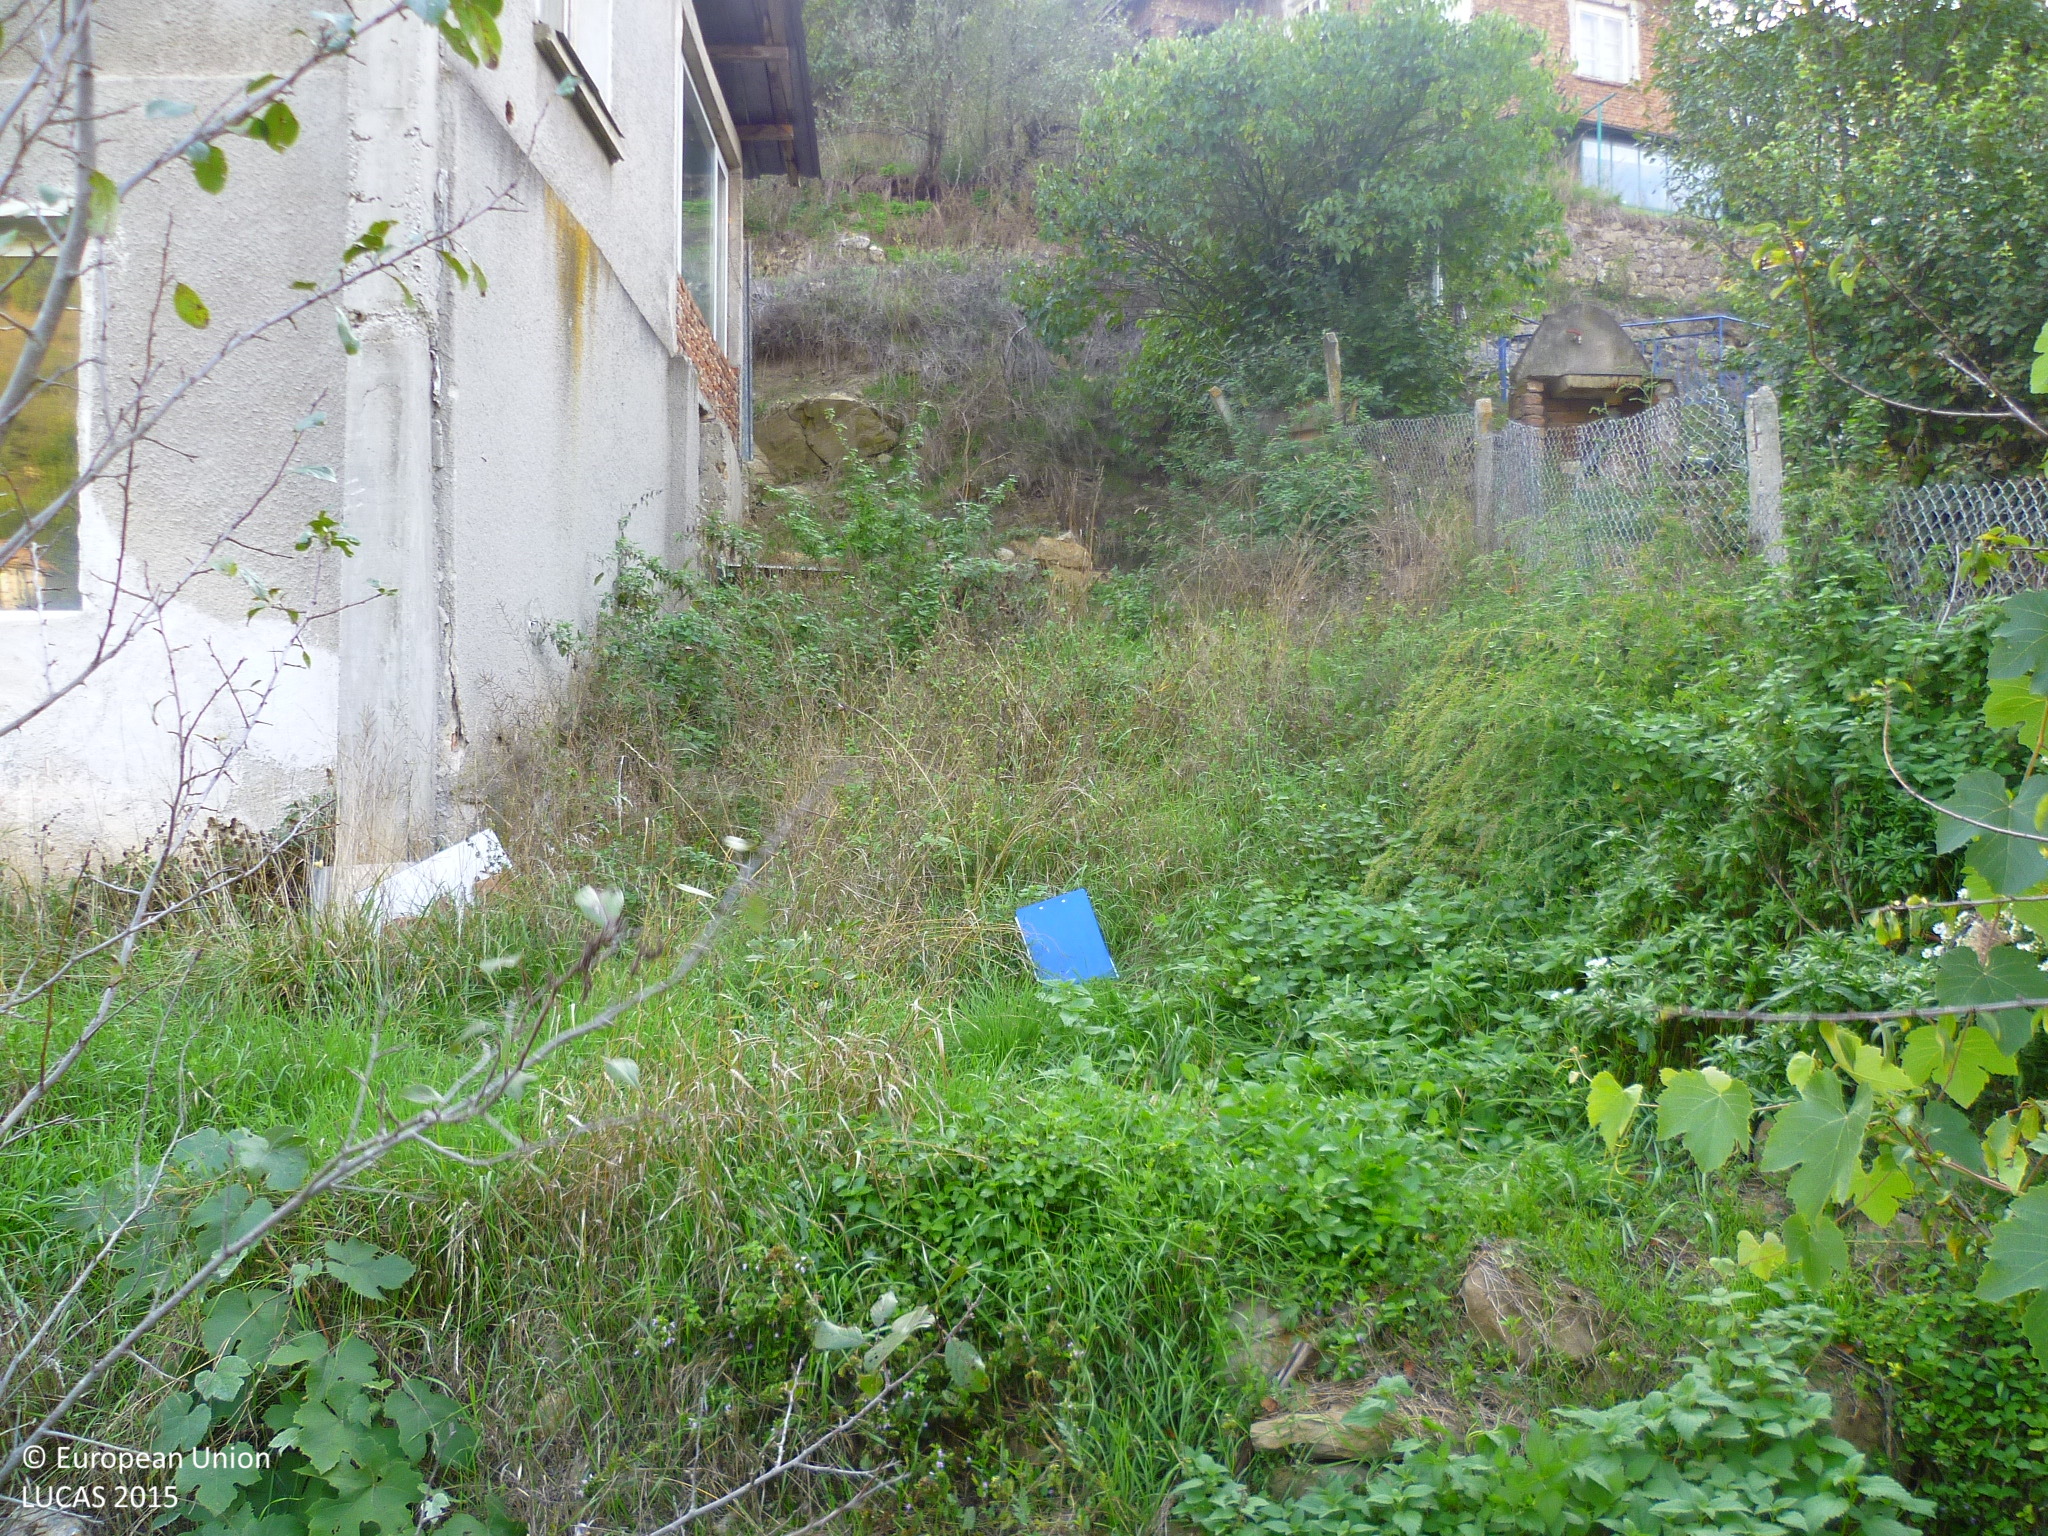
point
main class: Grassland
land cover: Grassland with sparse tree/shrub cover
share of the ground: 50 - 75 %
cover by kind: herbaceous plants 45 %, broadleaved forest trees 5 %, shrubs 5 %
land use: Residential
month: October
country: BG
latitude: 42.9147
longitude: 22.8057
